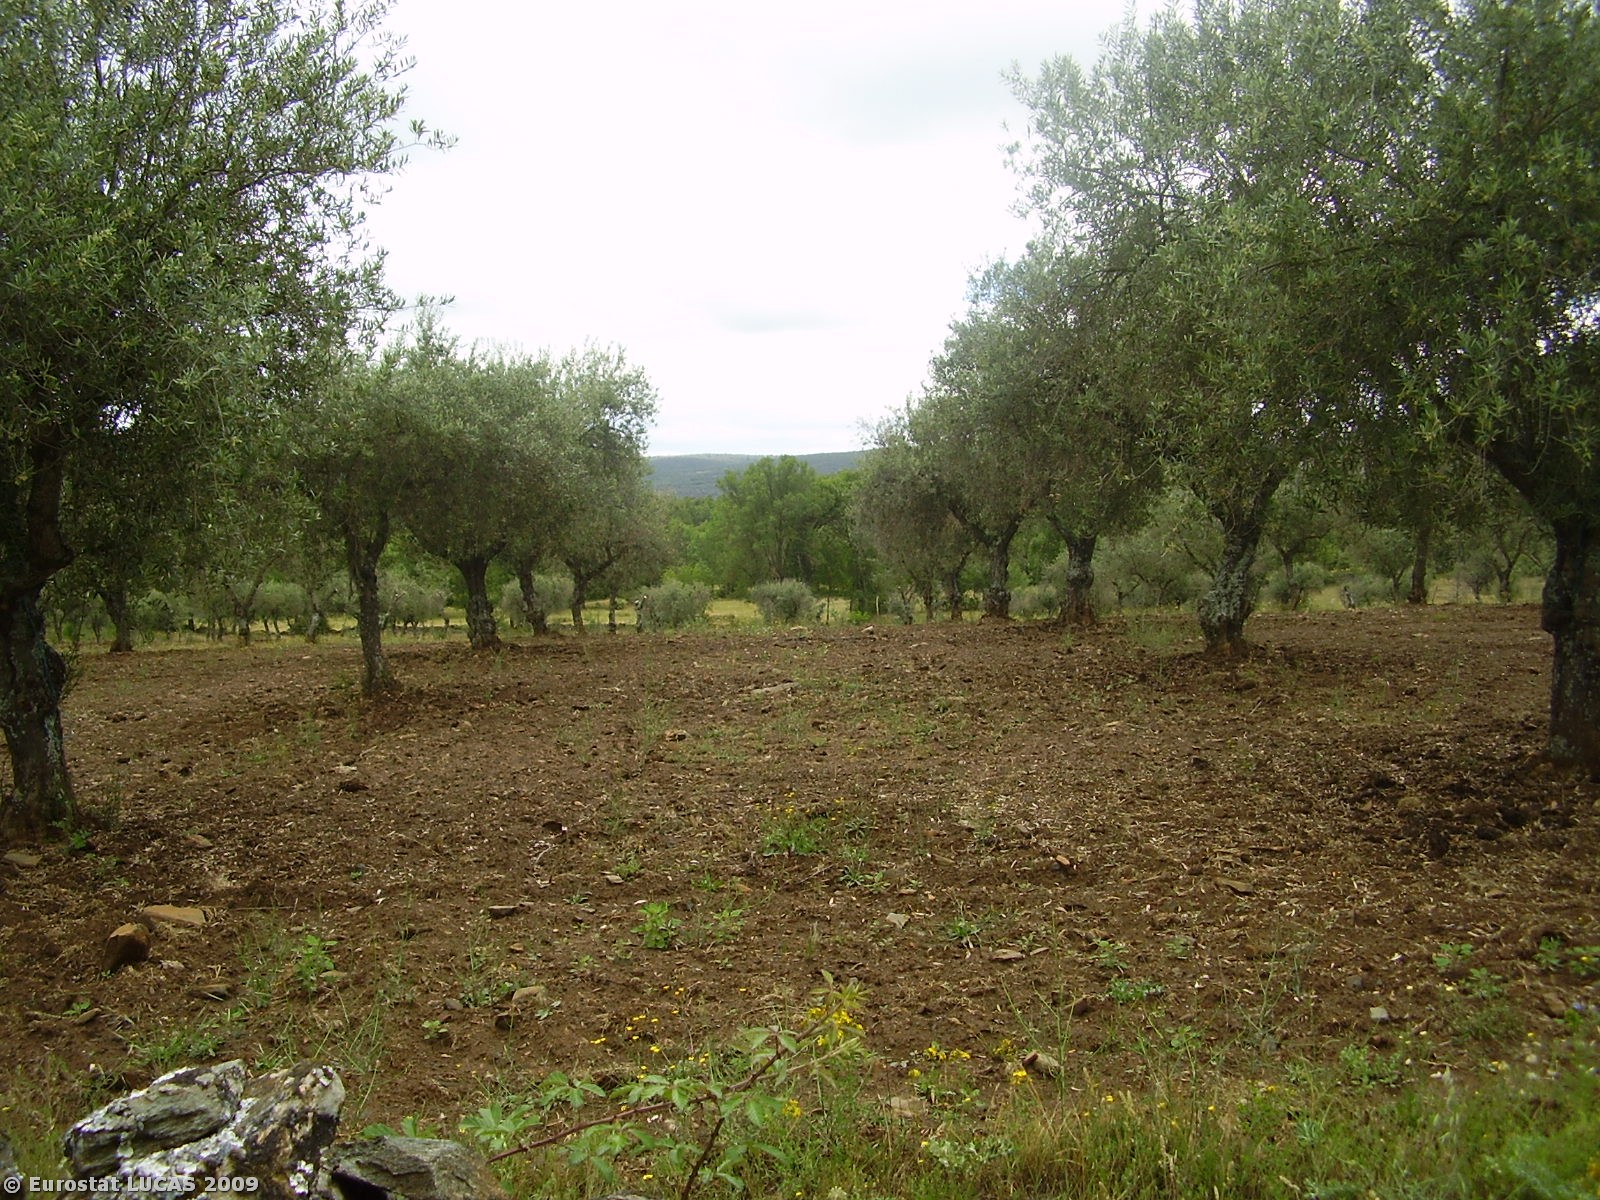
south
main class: Cropland
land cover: Olive groves
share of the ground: 10 - 25 %
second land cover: Bare land
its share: > 75 %
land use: Agriculture (excluding fallow land and kitchen gardens)
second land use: Unused
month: June
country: PT
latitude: 41.5540
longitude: -6.7875
